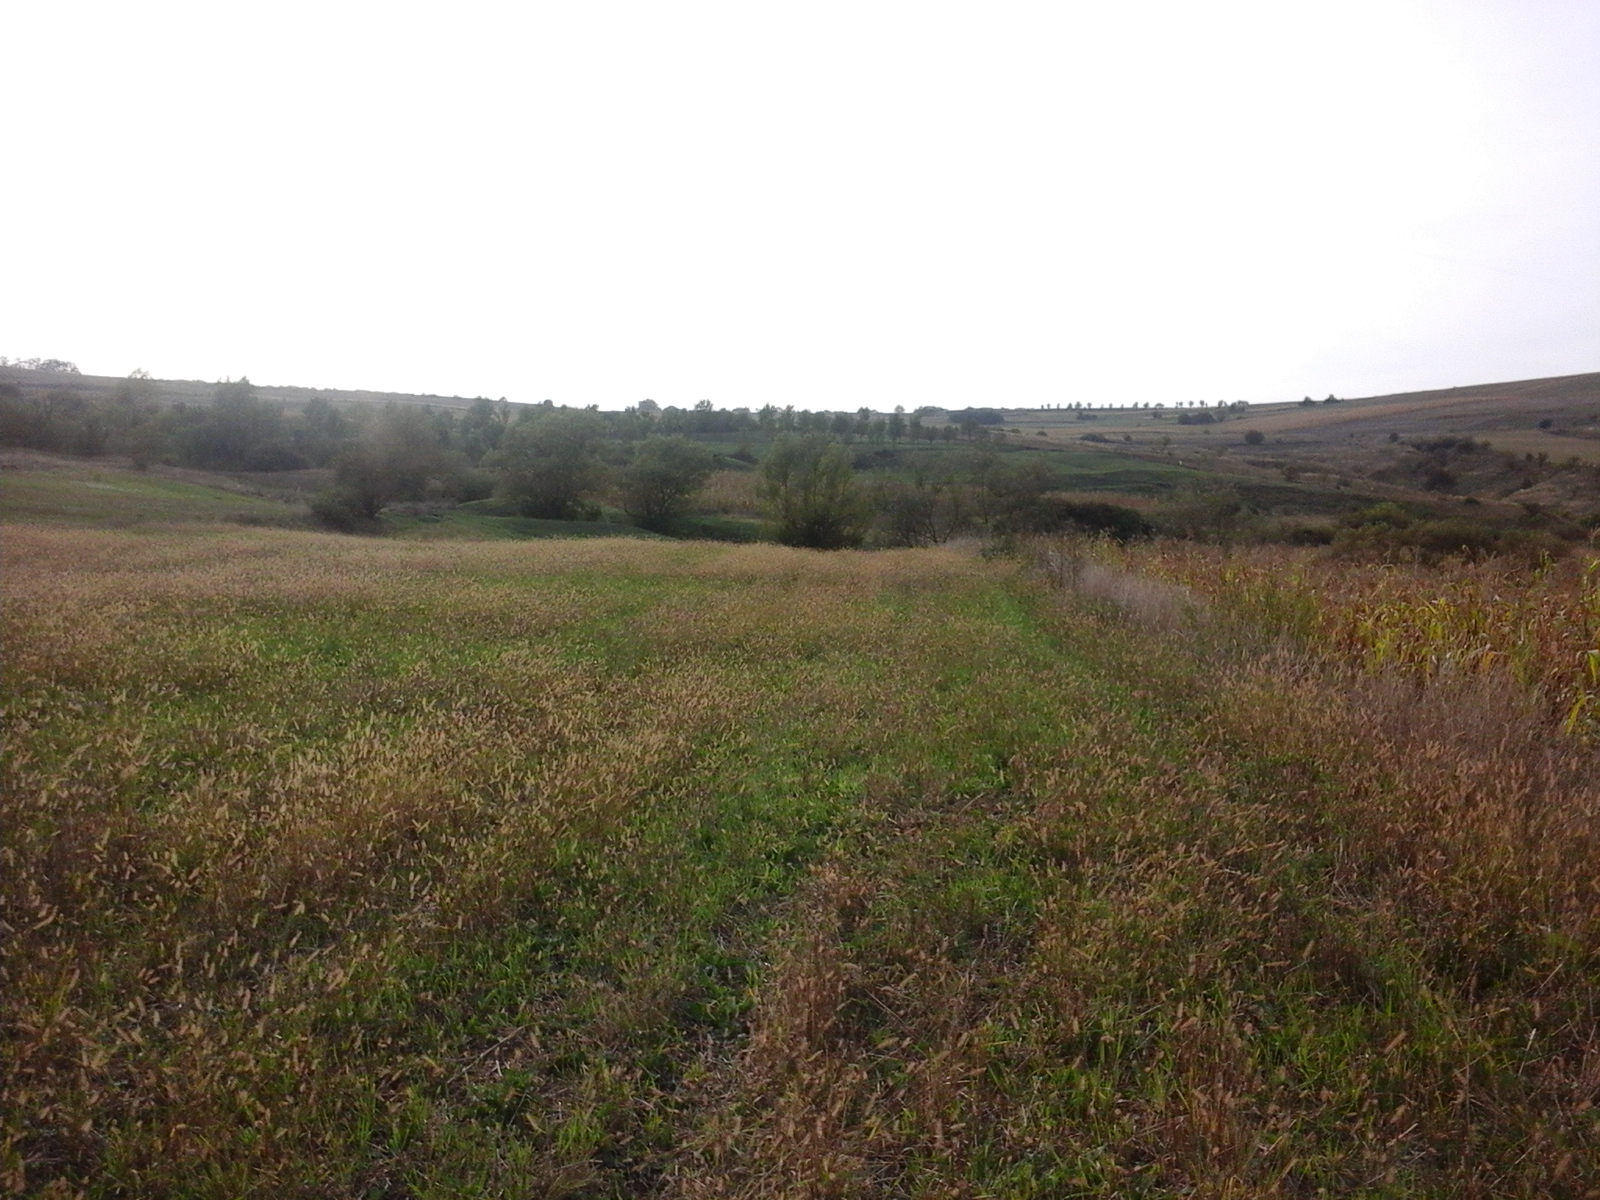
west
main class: Cropland
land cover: Maize
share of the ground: > 75 %
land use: Agriculture (excluding fallow land and kitchen gardens)
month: September
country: RO
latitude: 46.9712
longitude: 24.1872
